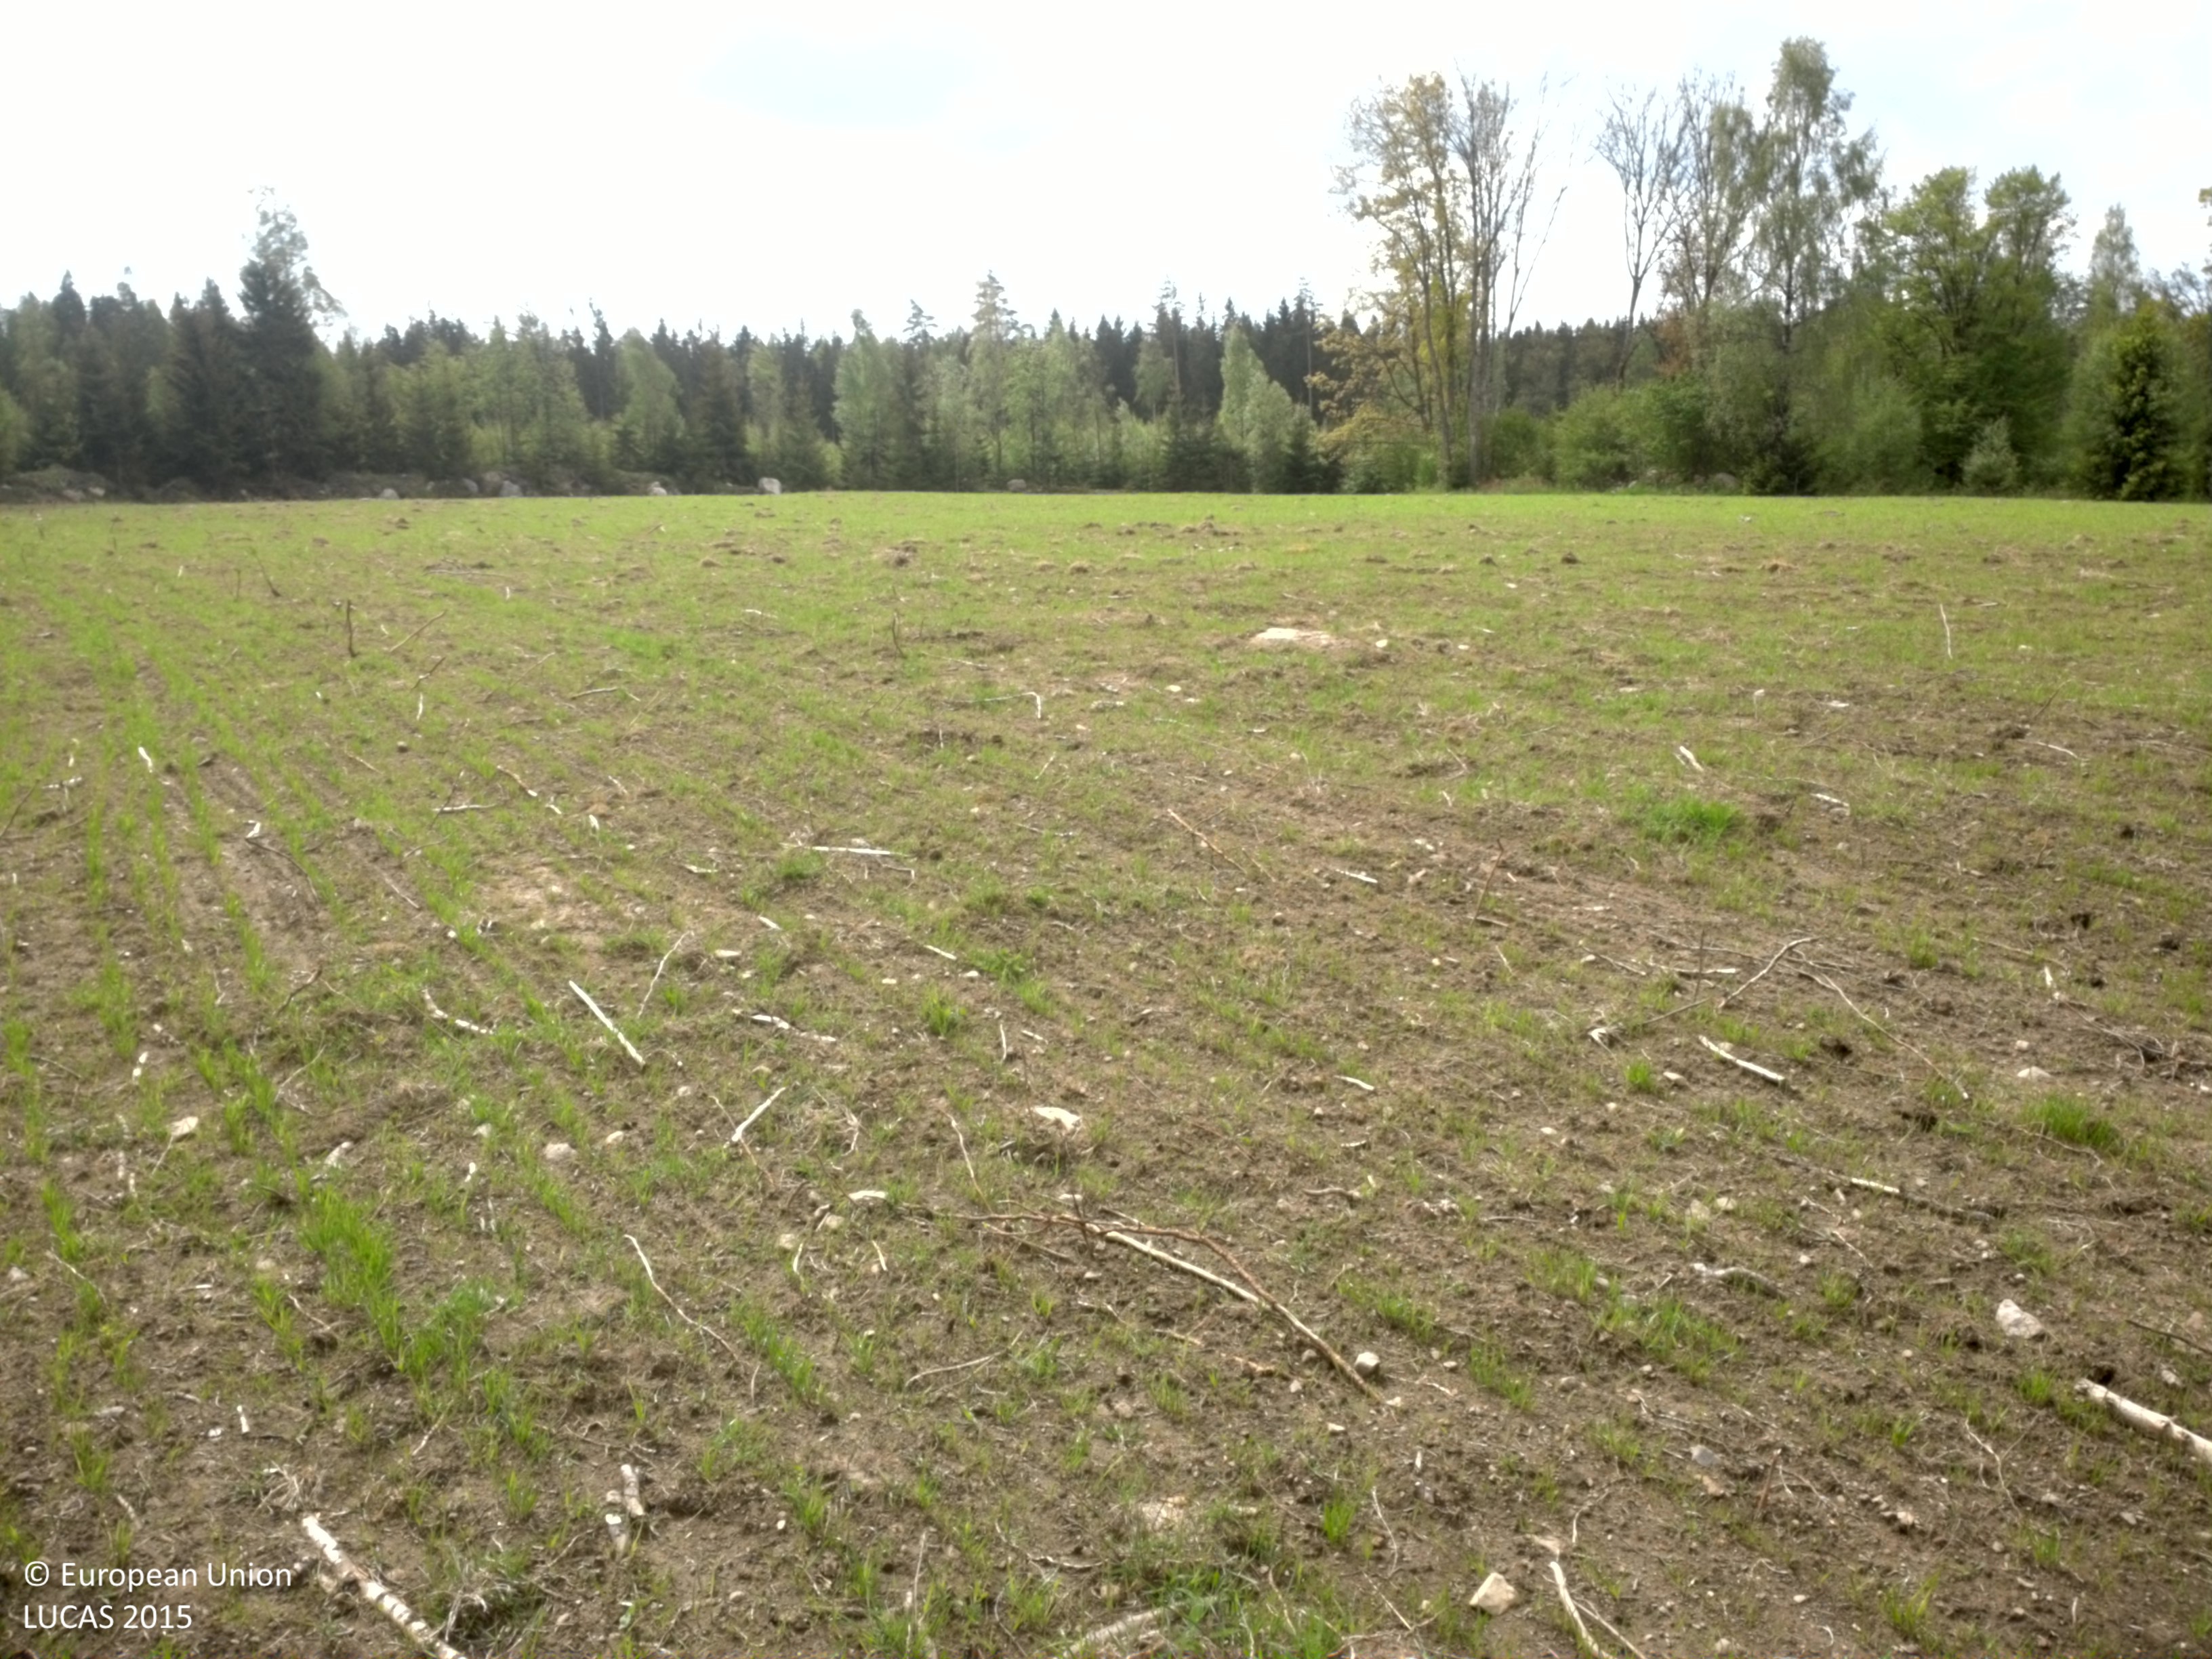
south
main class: Cropland
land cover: Other leguminous and mixtures for fodder
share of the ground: 25 - 50 %
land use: Agriculture (excluding fallow land and kitchen gardens)
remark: Tilled/Sowed
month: May
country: SE
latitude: 56.5322
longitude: 15.2176
